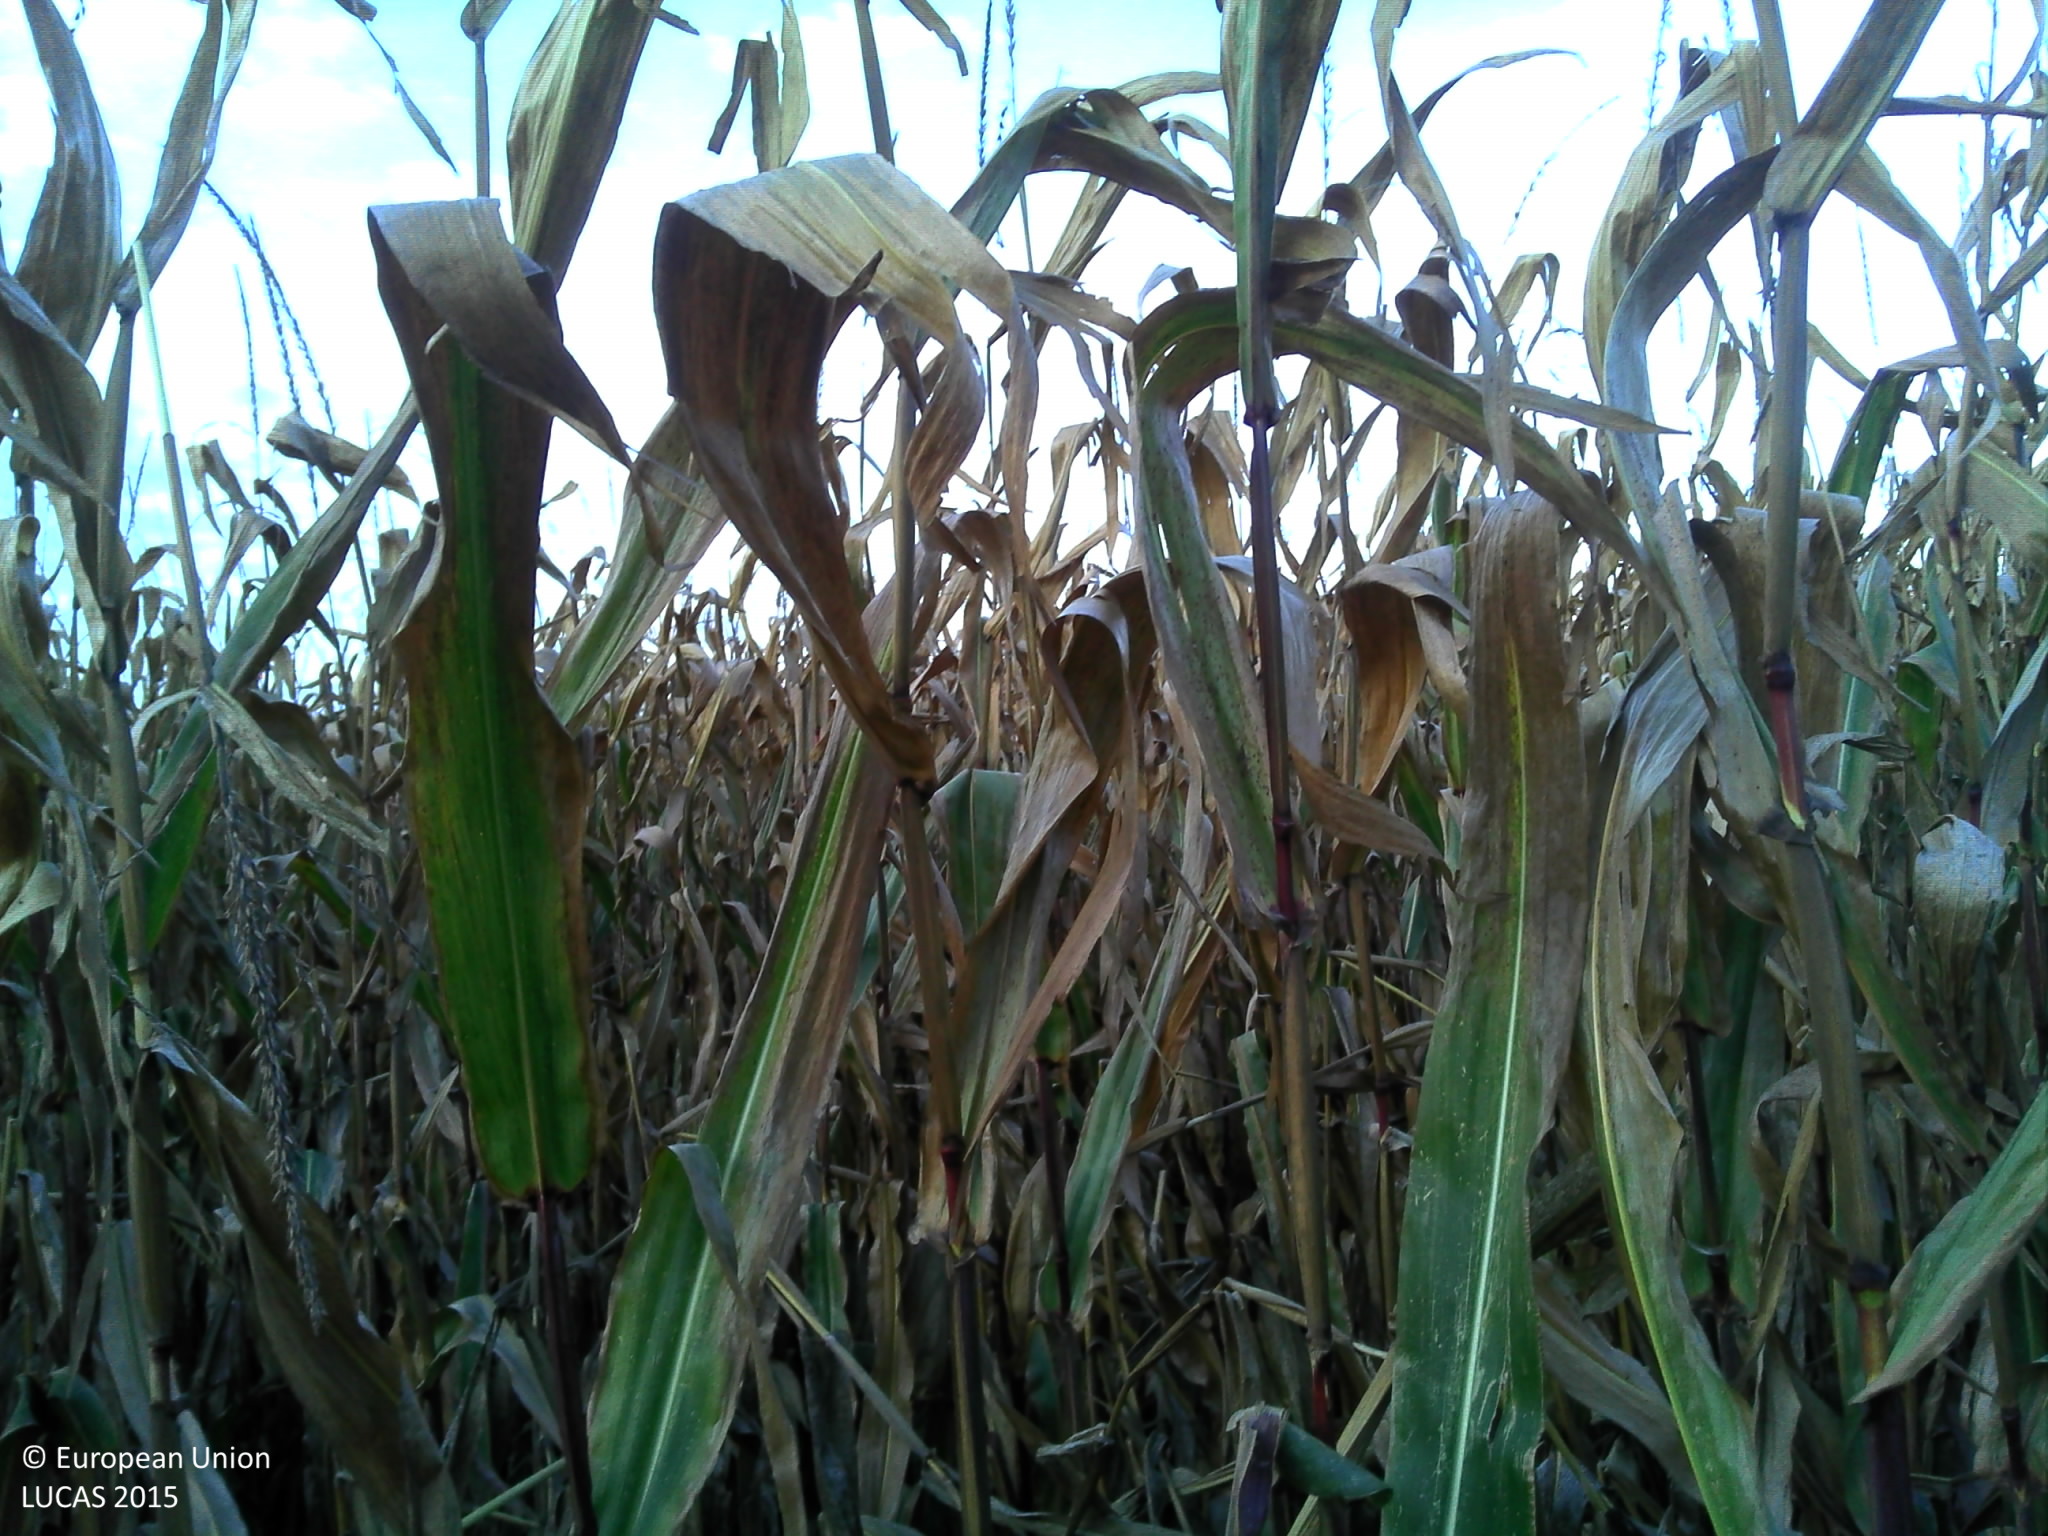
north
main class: Cropland
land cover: Maize
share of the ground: > 75 %
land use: Agriculture (excluding fallow land and kitchen gardens)
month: October
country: FR
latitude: 46.4187
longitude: -0.8155
